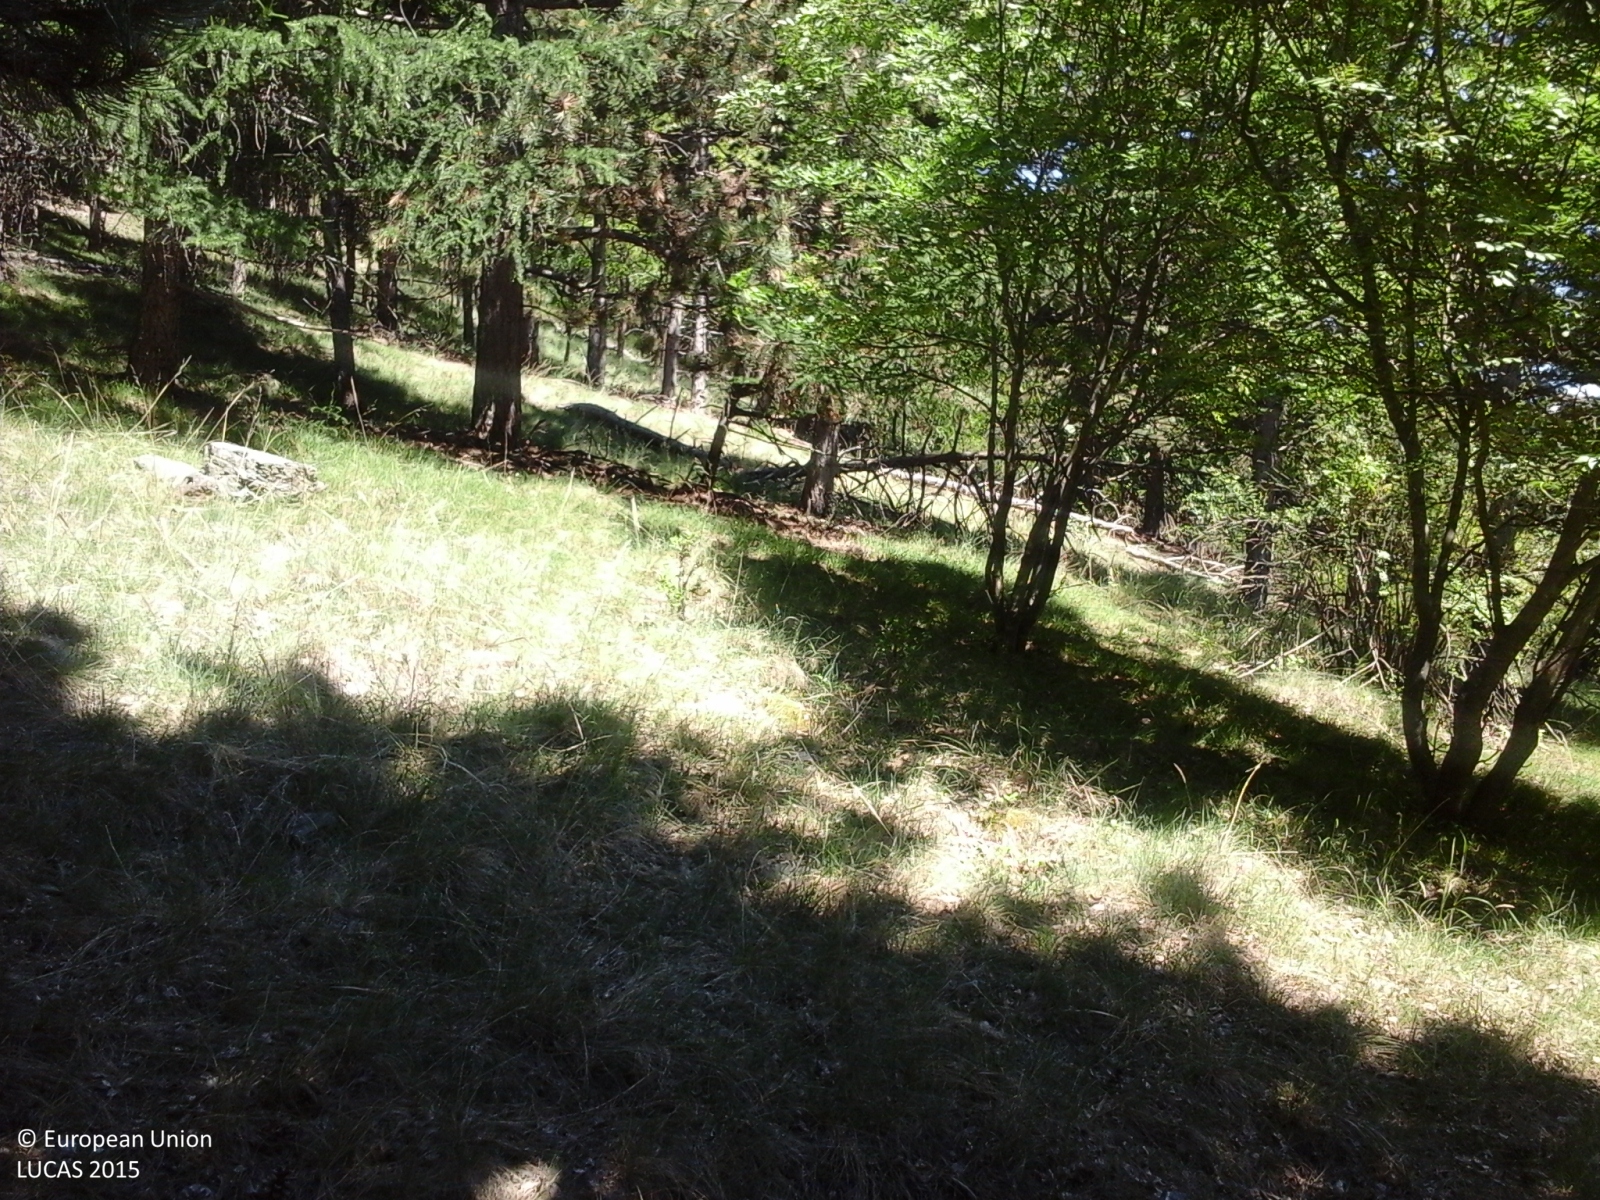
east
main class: Woodland
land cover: Pine dominated mixed woodland
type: alpine coniferous forest
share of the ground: > 75 %
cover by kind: coniferous forest trees 70 %, broadleaved forest trees 30 %
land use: Forestry
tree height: > 5 m
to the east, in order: Pine dominated mixed woodland; Electric lines; Pine dominated mixed woodland
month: May
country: IT
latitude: 46.6376
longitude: 10.6132
